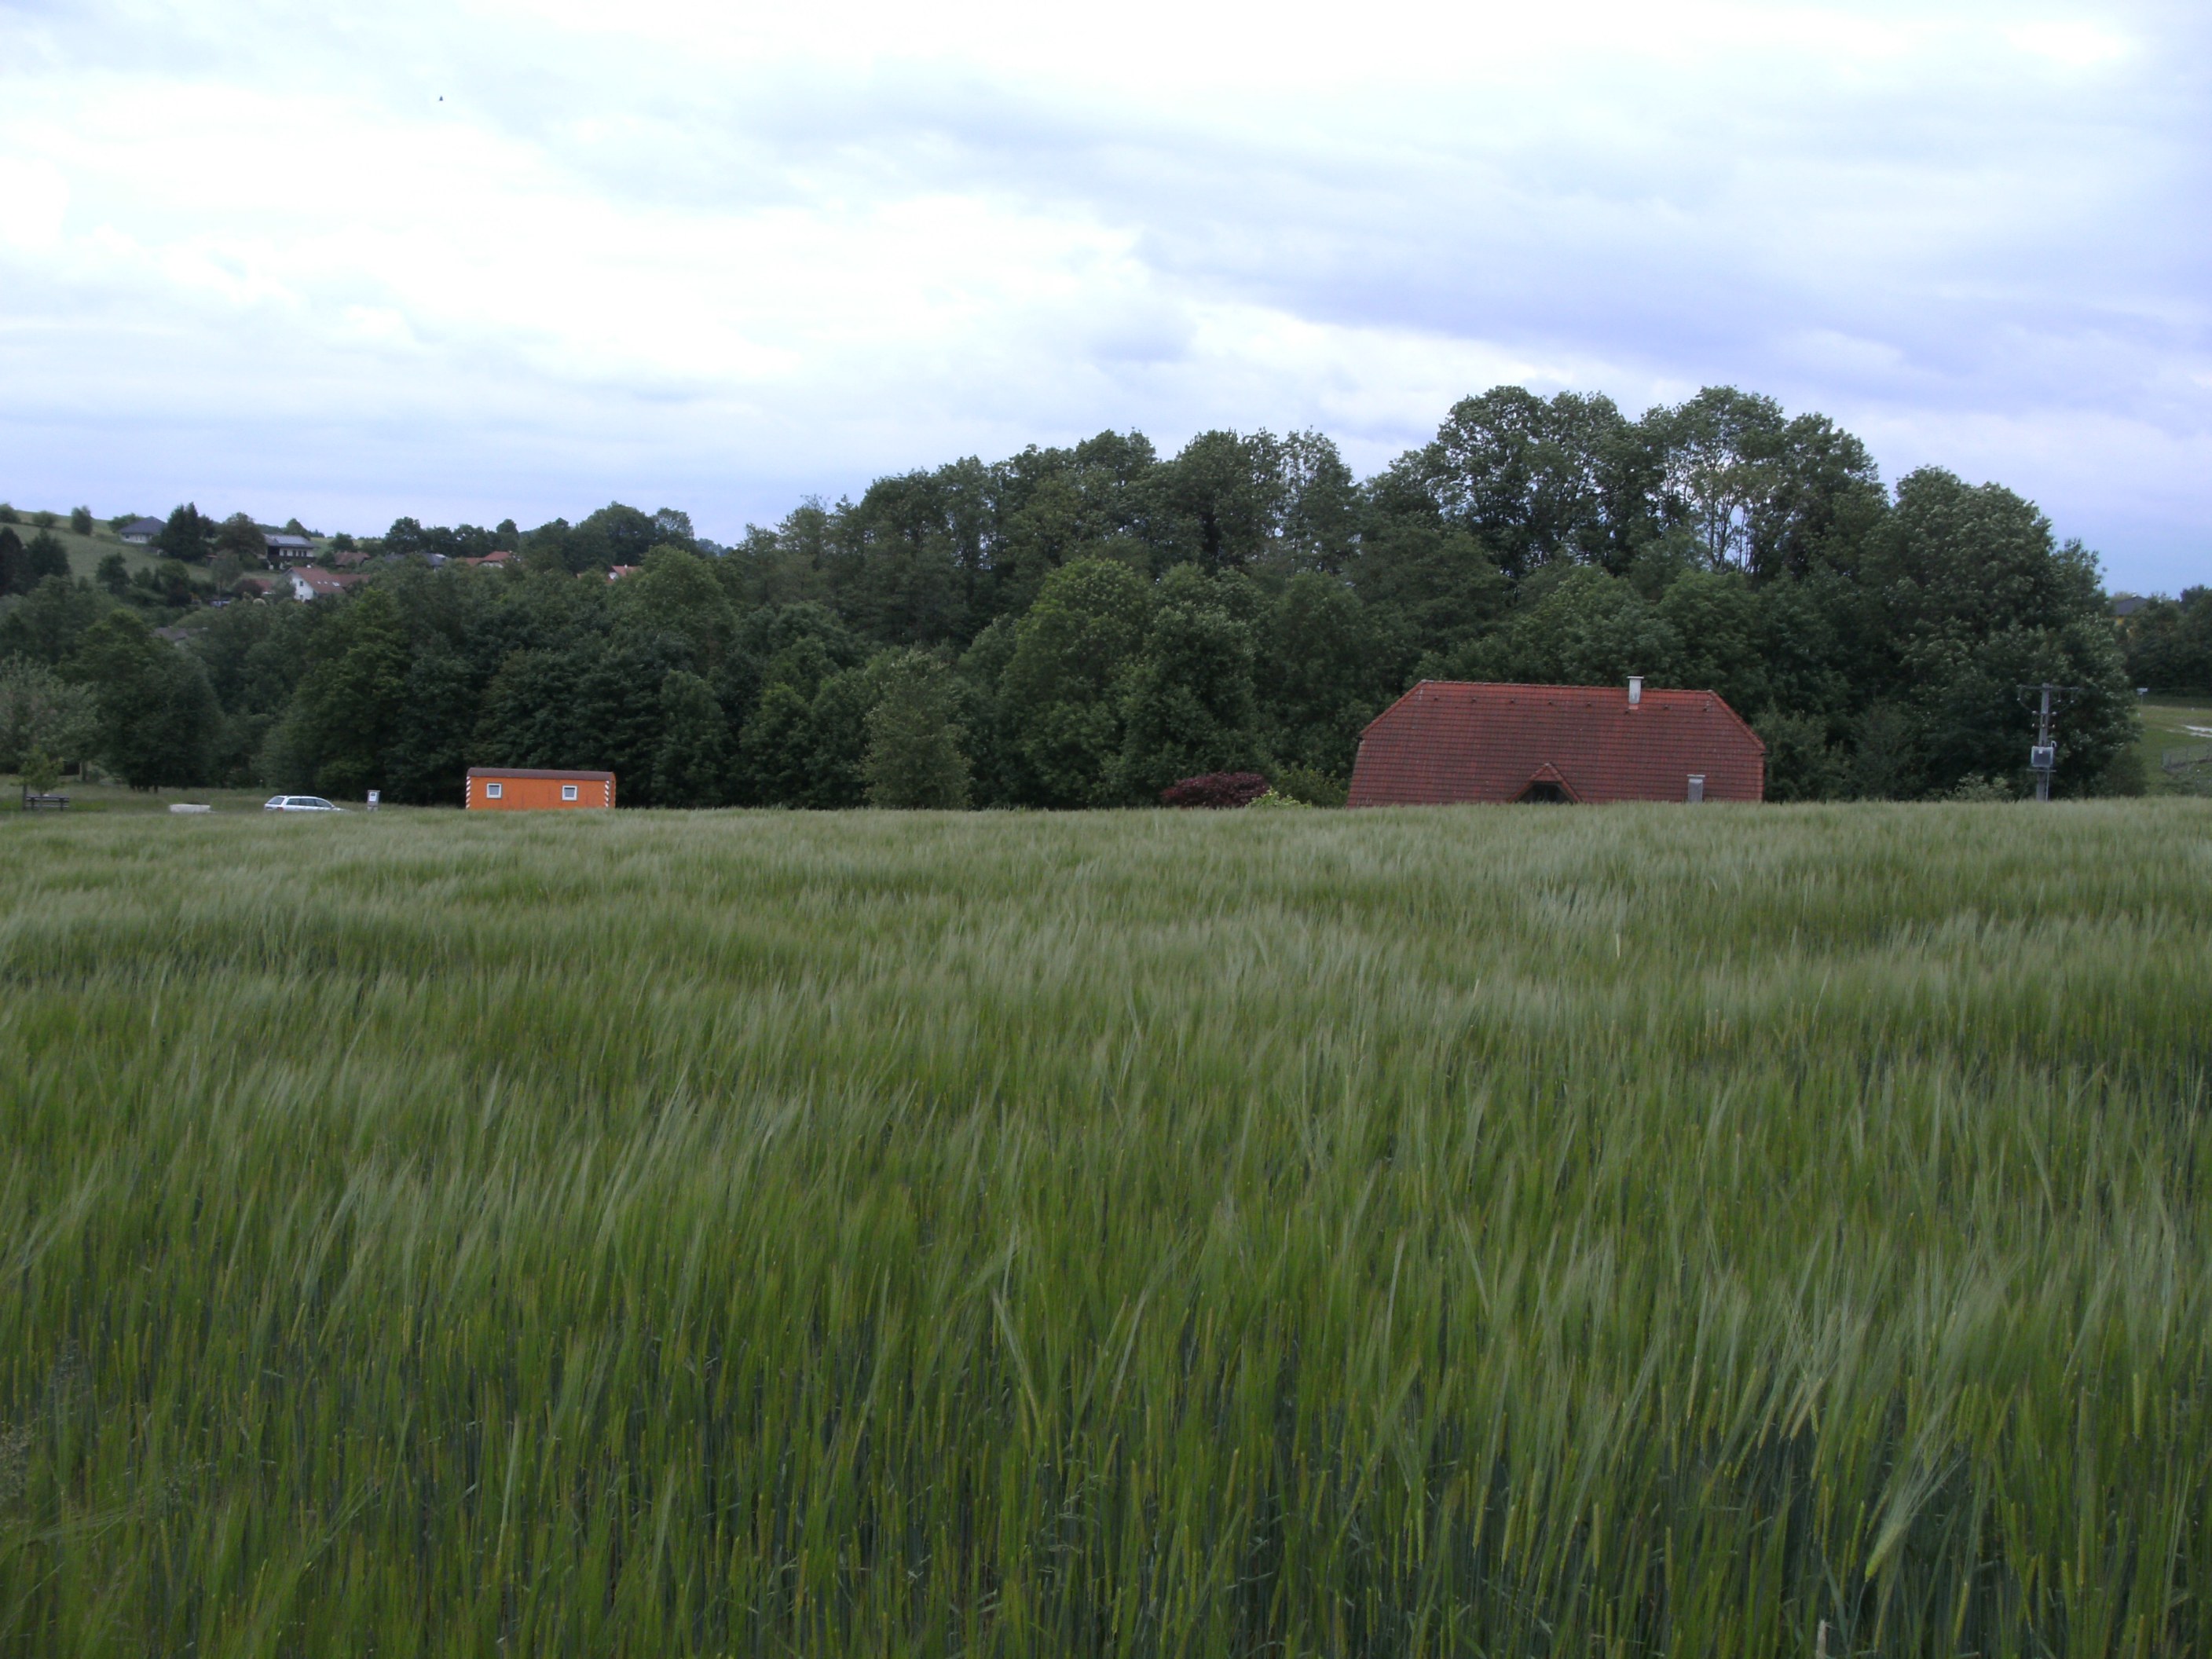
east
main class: Cropland
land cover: Barley
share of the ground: > 75 %
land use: Agriculture (excluding fallow land and kitchen gardens)
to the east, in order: Barley; Grassland without tree/shrub cover; Pear fruit; Paved roads, cycling and walking lanes; Grassland without tree/shrub cover; Broadleaved woodland; Rivers and streams; Broadleaved woodland; Grassland without tree/shrub cover; Common wheat
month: May
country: AT
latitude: 48.2370
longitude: 13.5943
